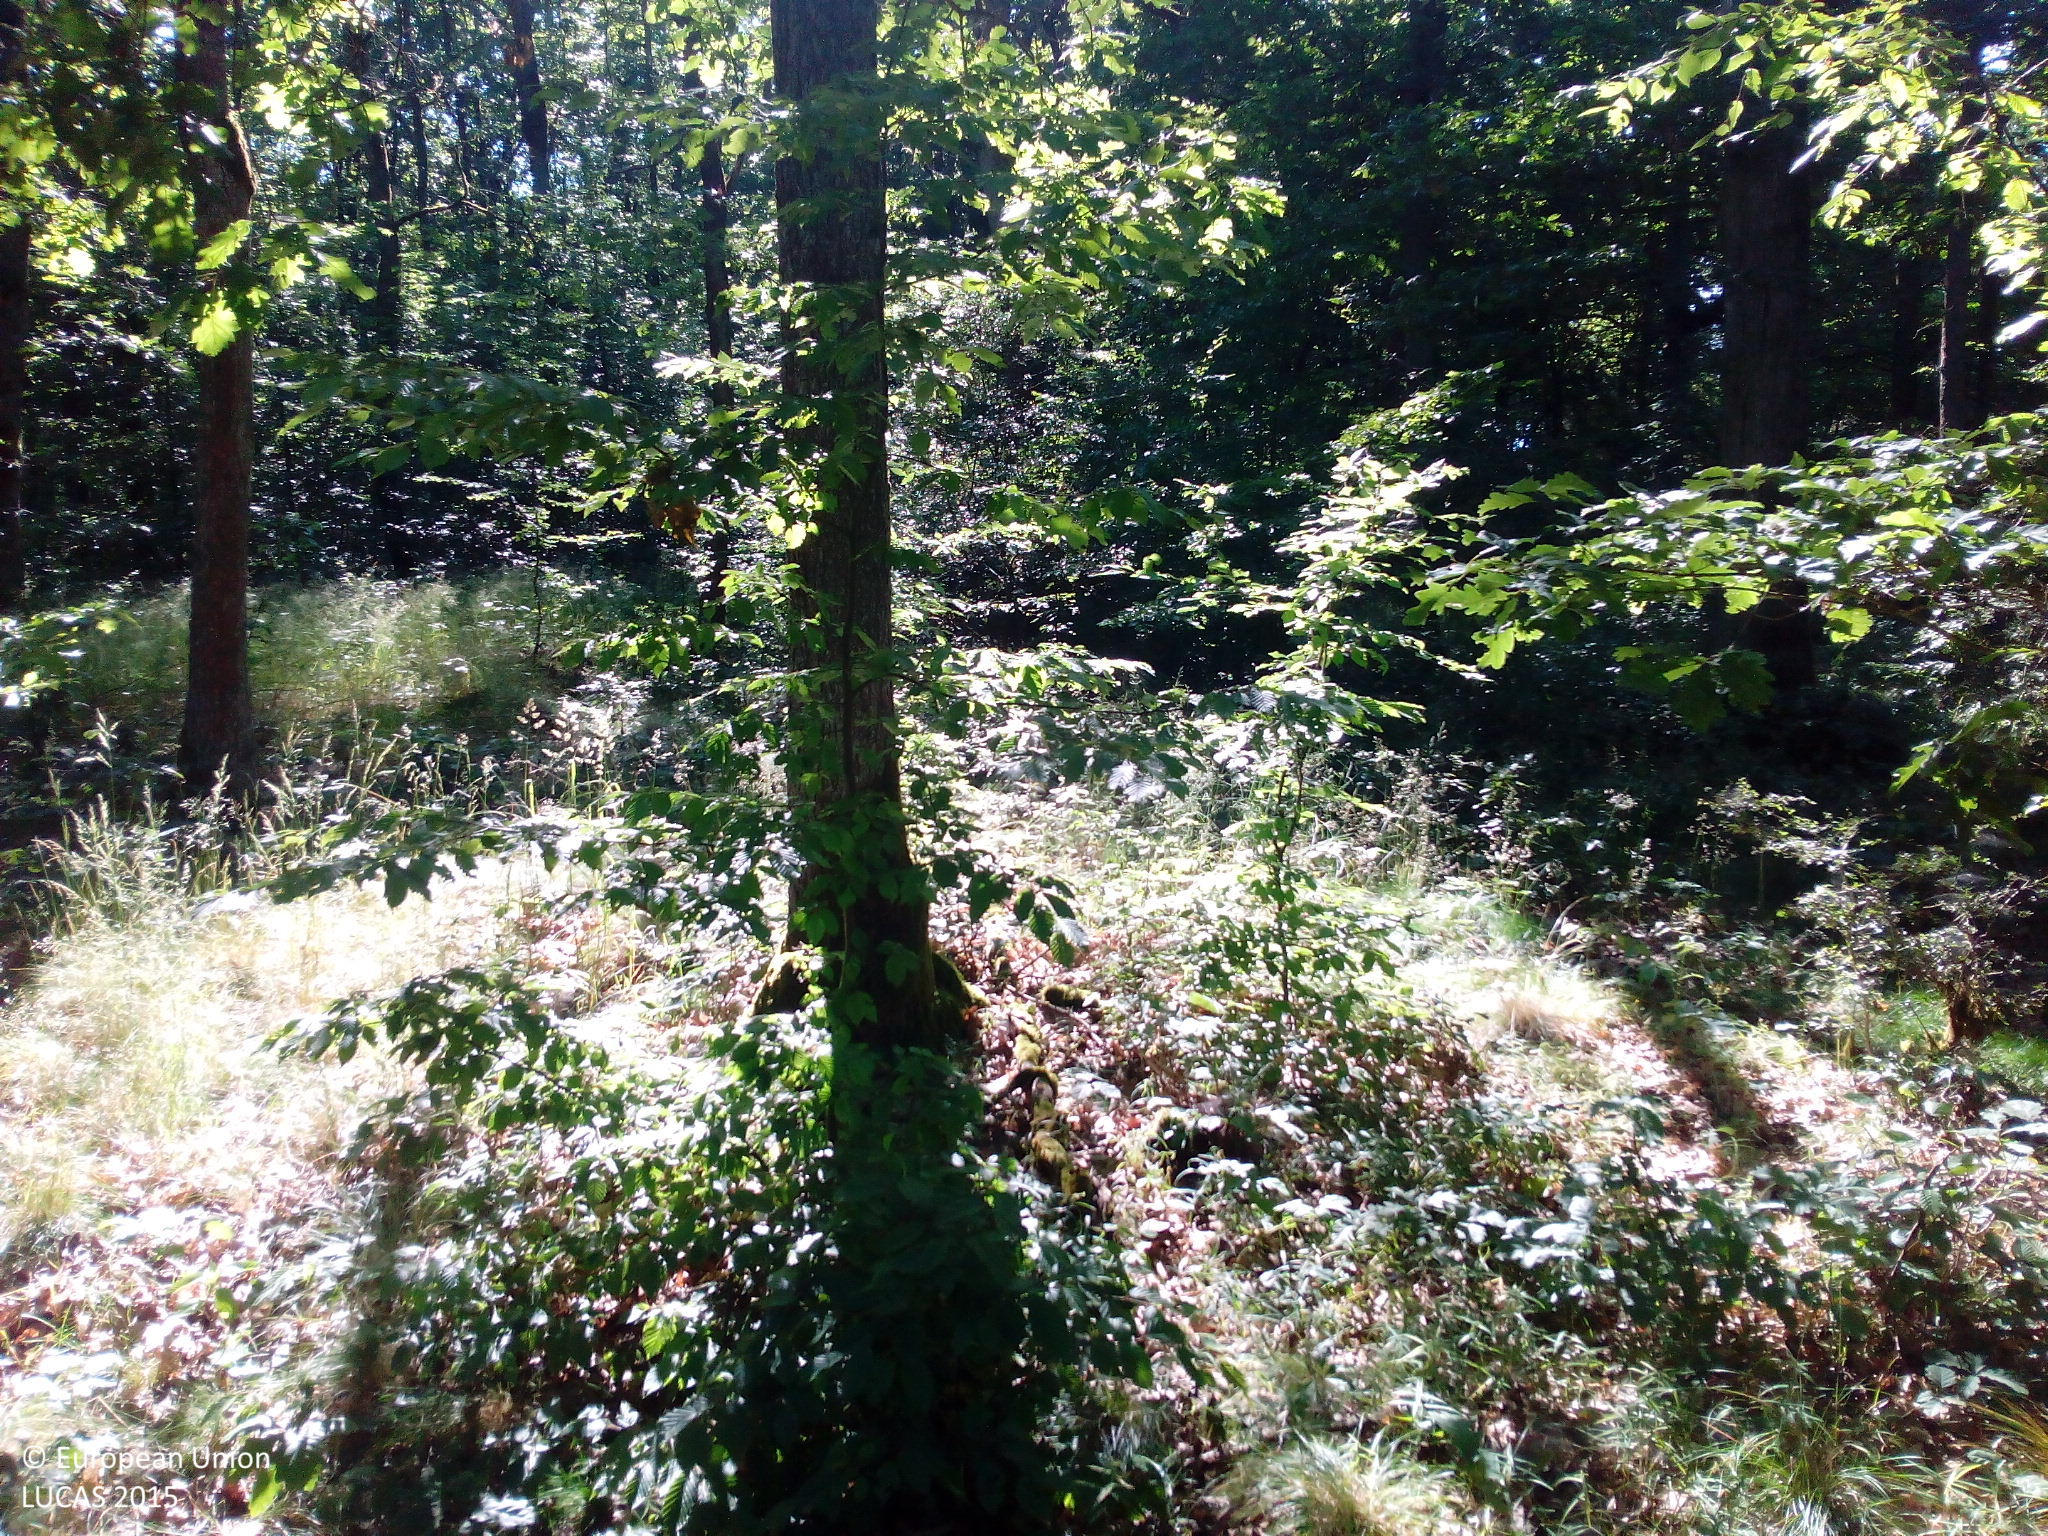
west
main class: Woodland
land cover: Broadleaved woodland
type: mesophytic deciduous forest
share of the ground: > 75 %
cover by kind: broadleaved forest trees 85 %, herbaceous plants 15 %
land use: Forestry
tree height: > 5 m
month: July
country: DE
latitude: 50.3443
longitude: 10.6321
